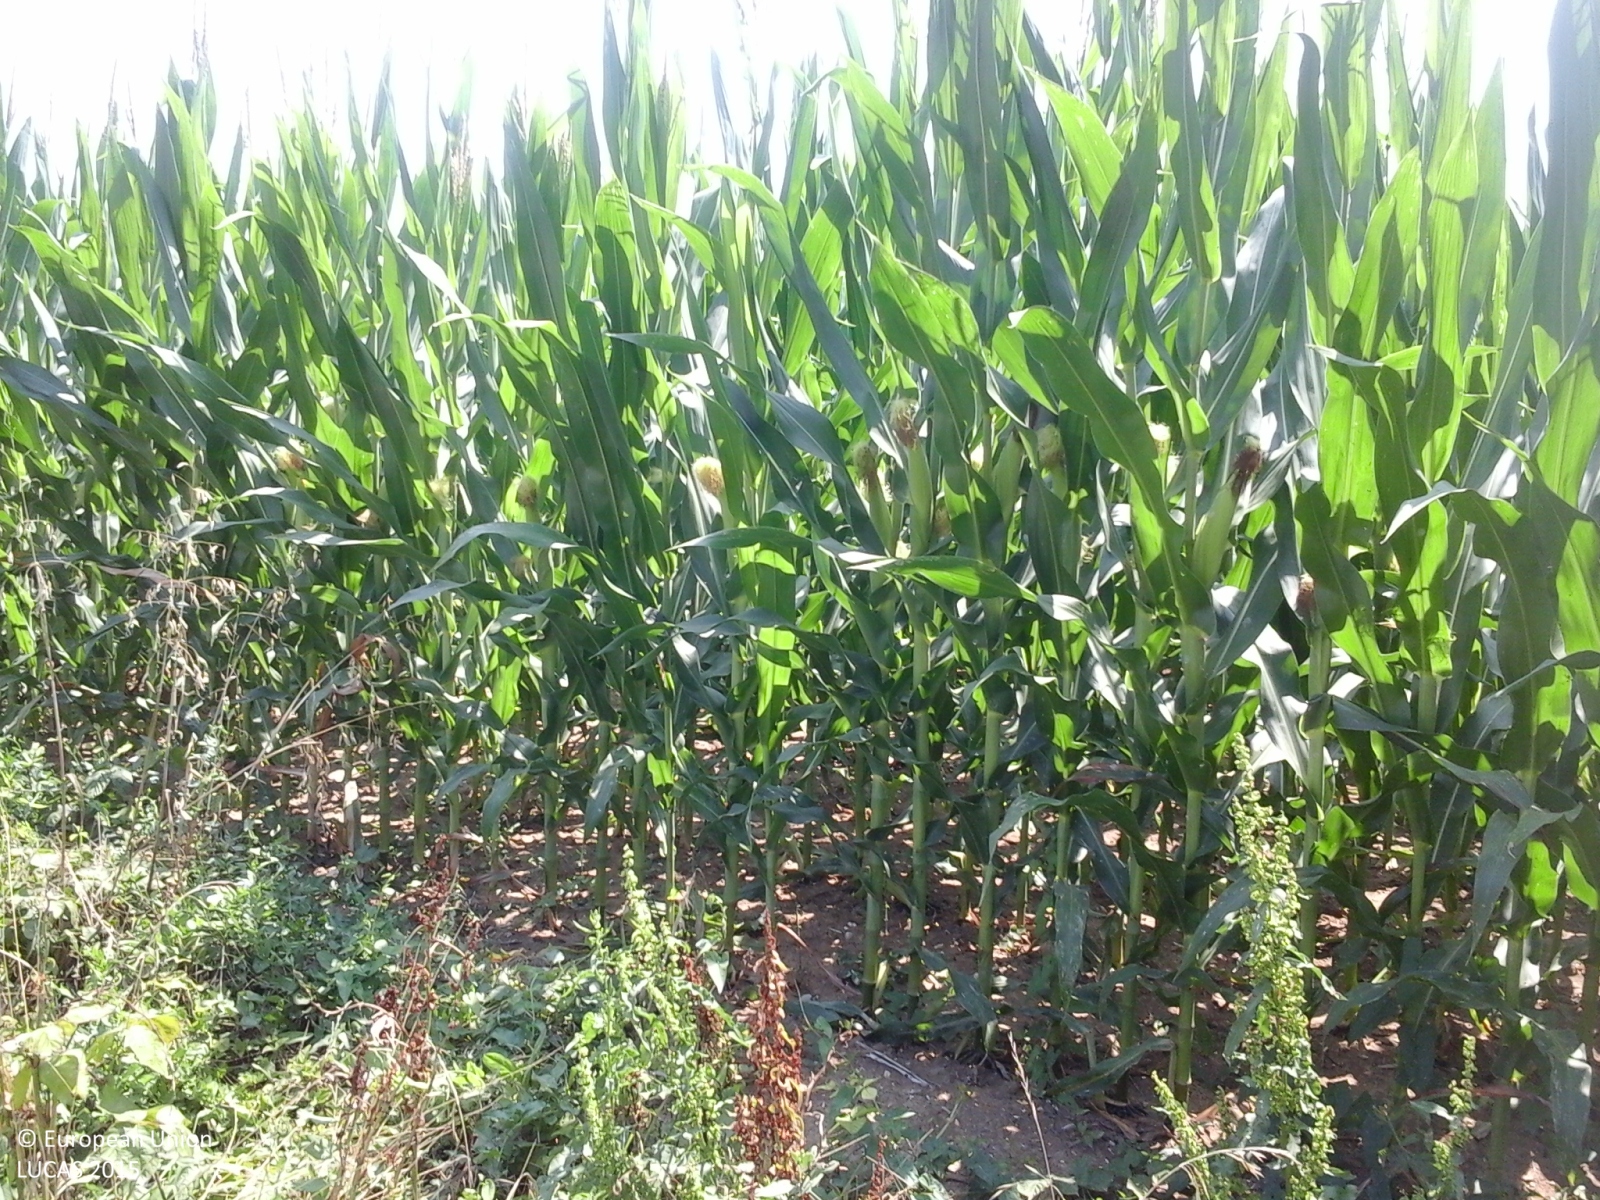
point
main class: Cropland
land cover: Maize
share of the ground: > 75 %
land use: Agriculture (excluding fallow land and kitchen gardens)
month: July
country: IT
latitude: 45.2662
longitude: 10.9033
